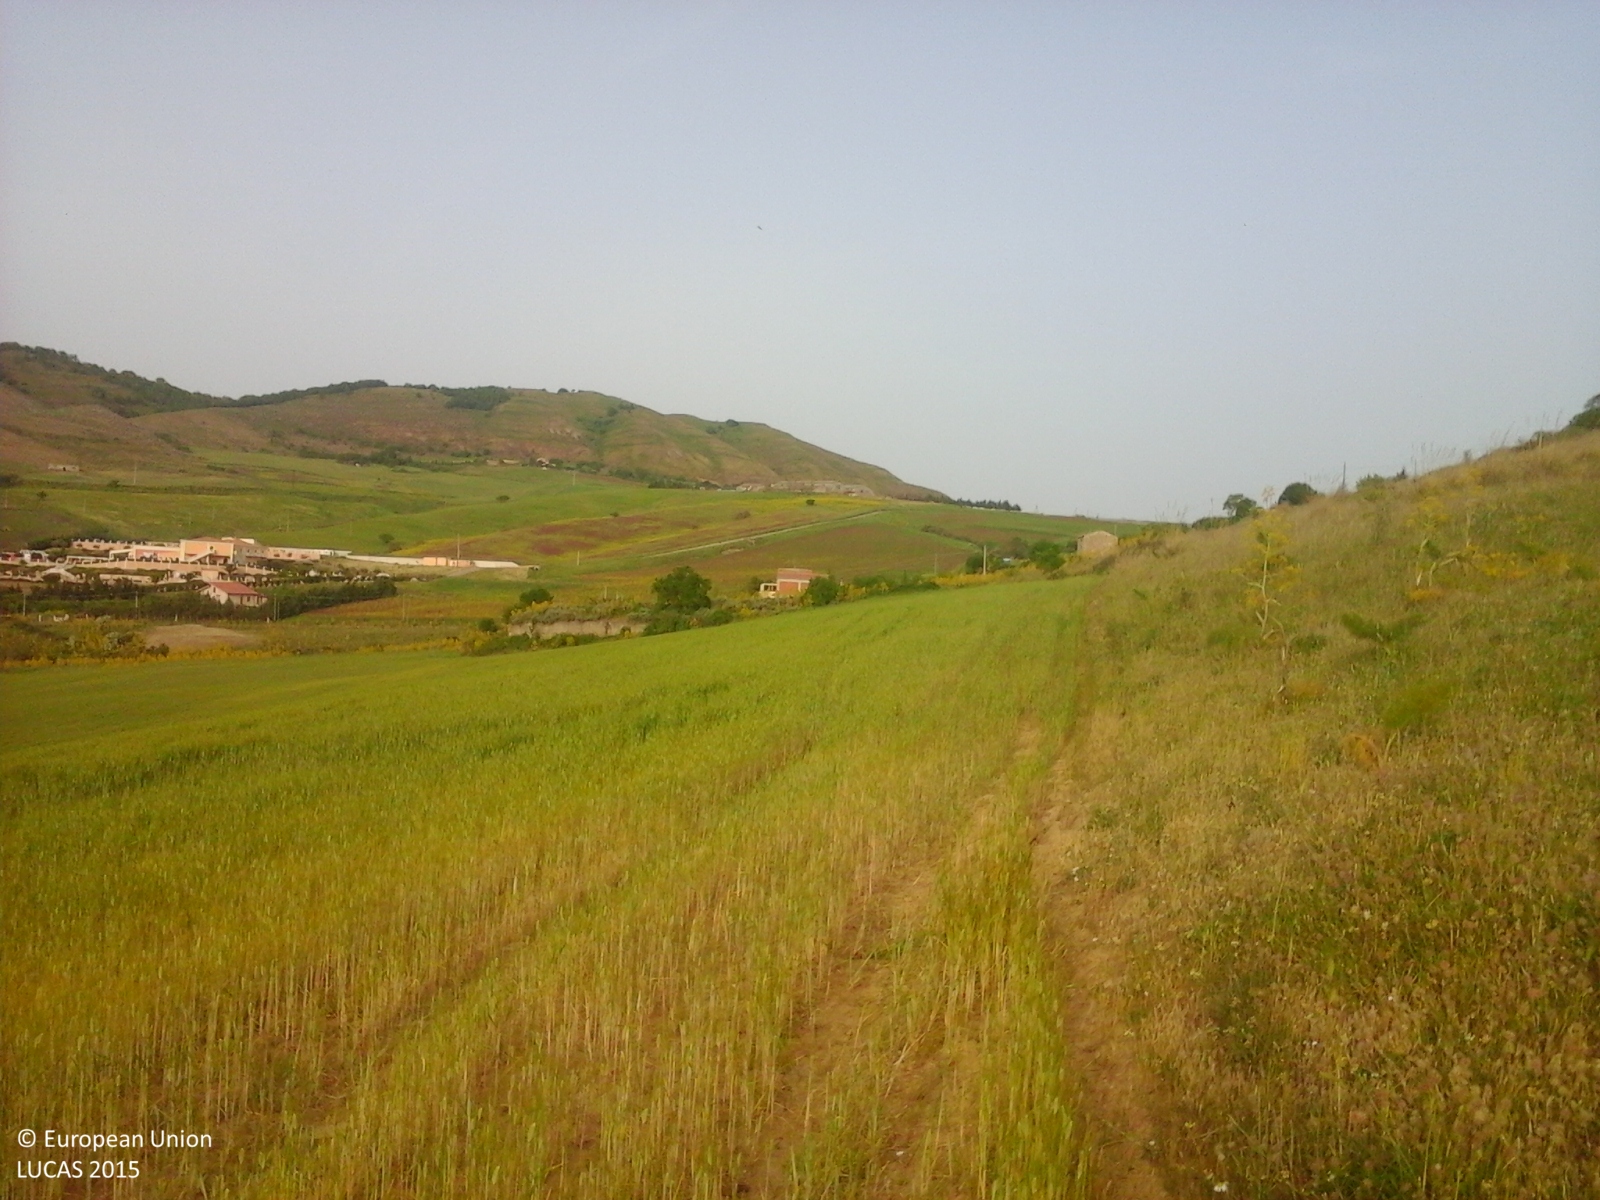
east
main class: Cropland
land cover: Durum wheat
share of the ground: > 75 %
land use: Agriculture (excluding fallow land and kitchen gardens)
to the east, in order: Durum wheat; Grassland without tree/shrub cover; Shrubland without tree cover; Durum wheat
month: May
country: IT
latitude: 37.7817
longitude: 14.2052
